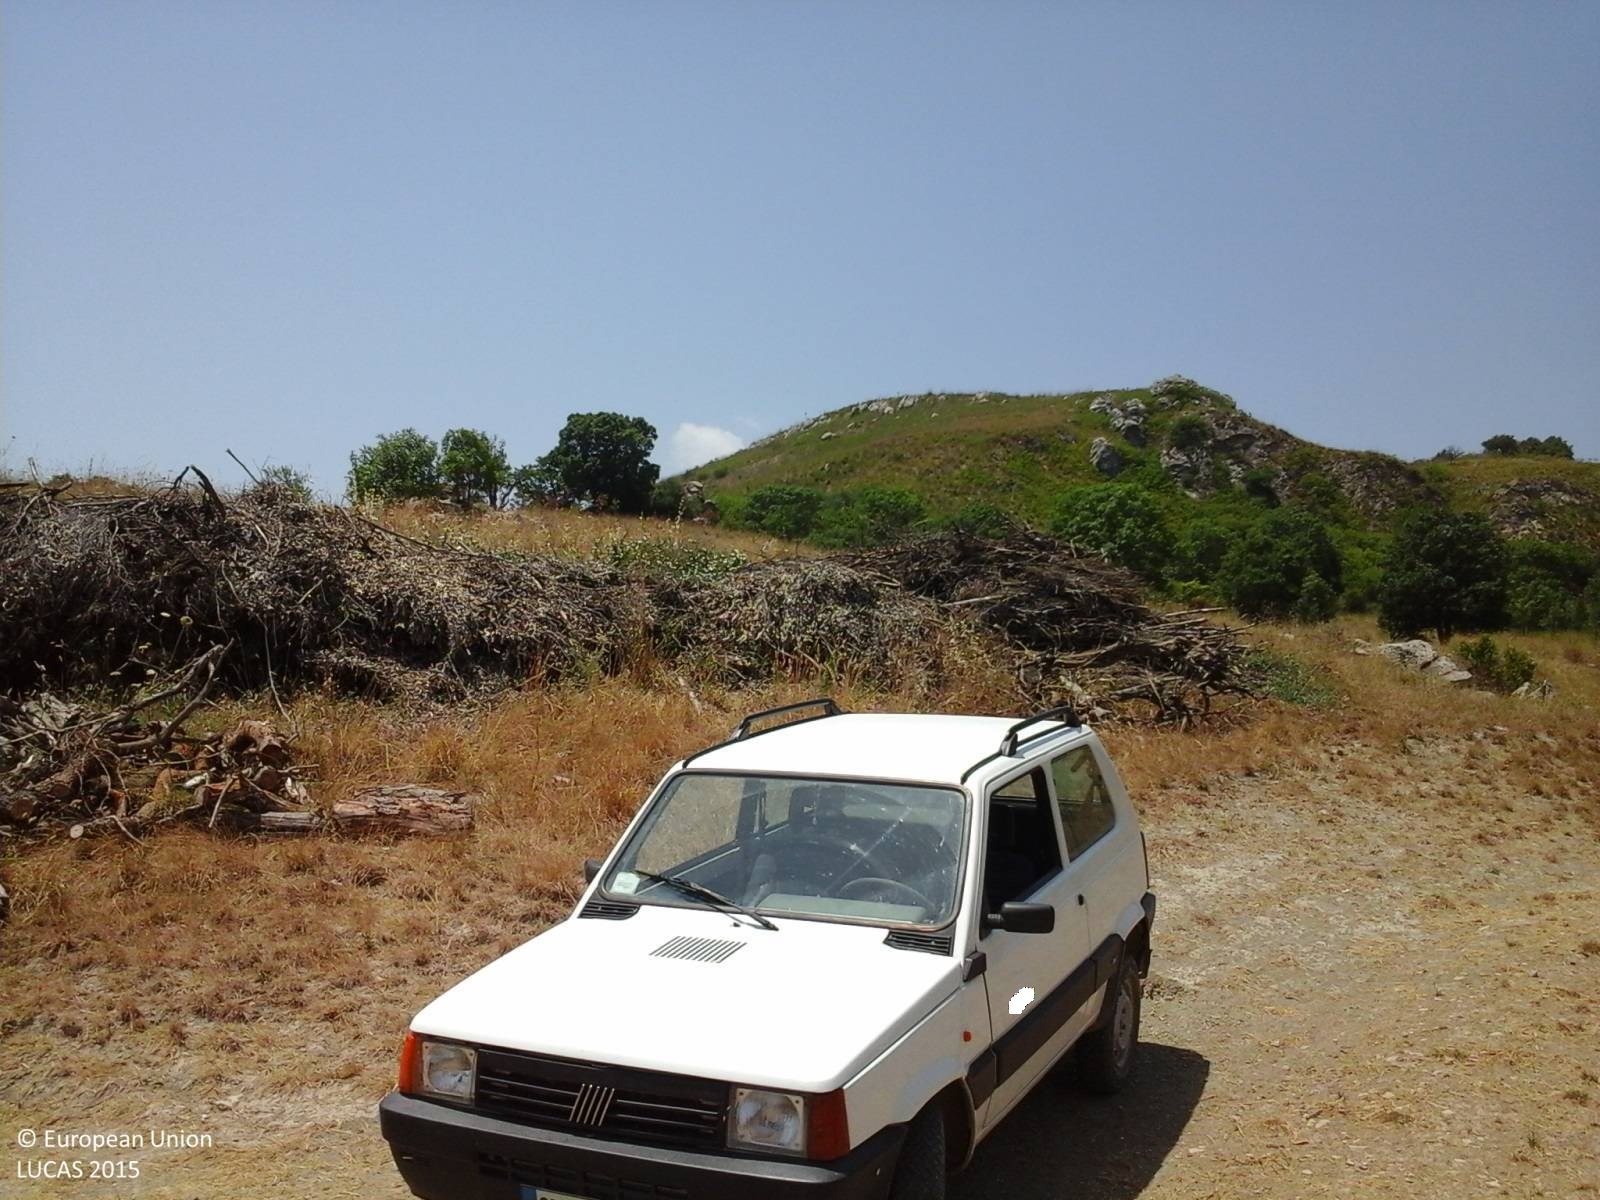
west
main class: Grassland
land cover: Grassland without tree/shrub cover
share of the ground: > 75 %
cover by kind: herbaceous plants 100 %
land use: Abandoned areas
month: July
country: IT
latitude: 37.7202
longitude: 13.4799
